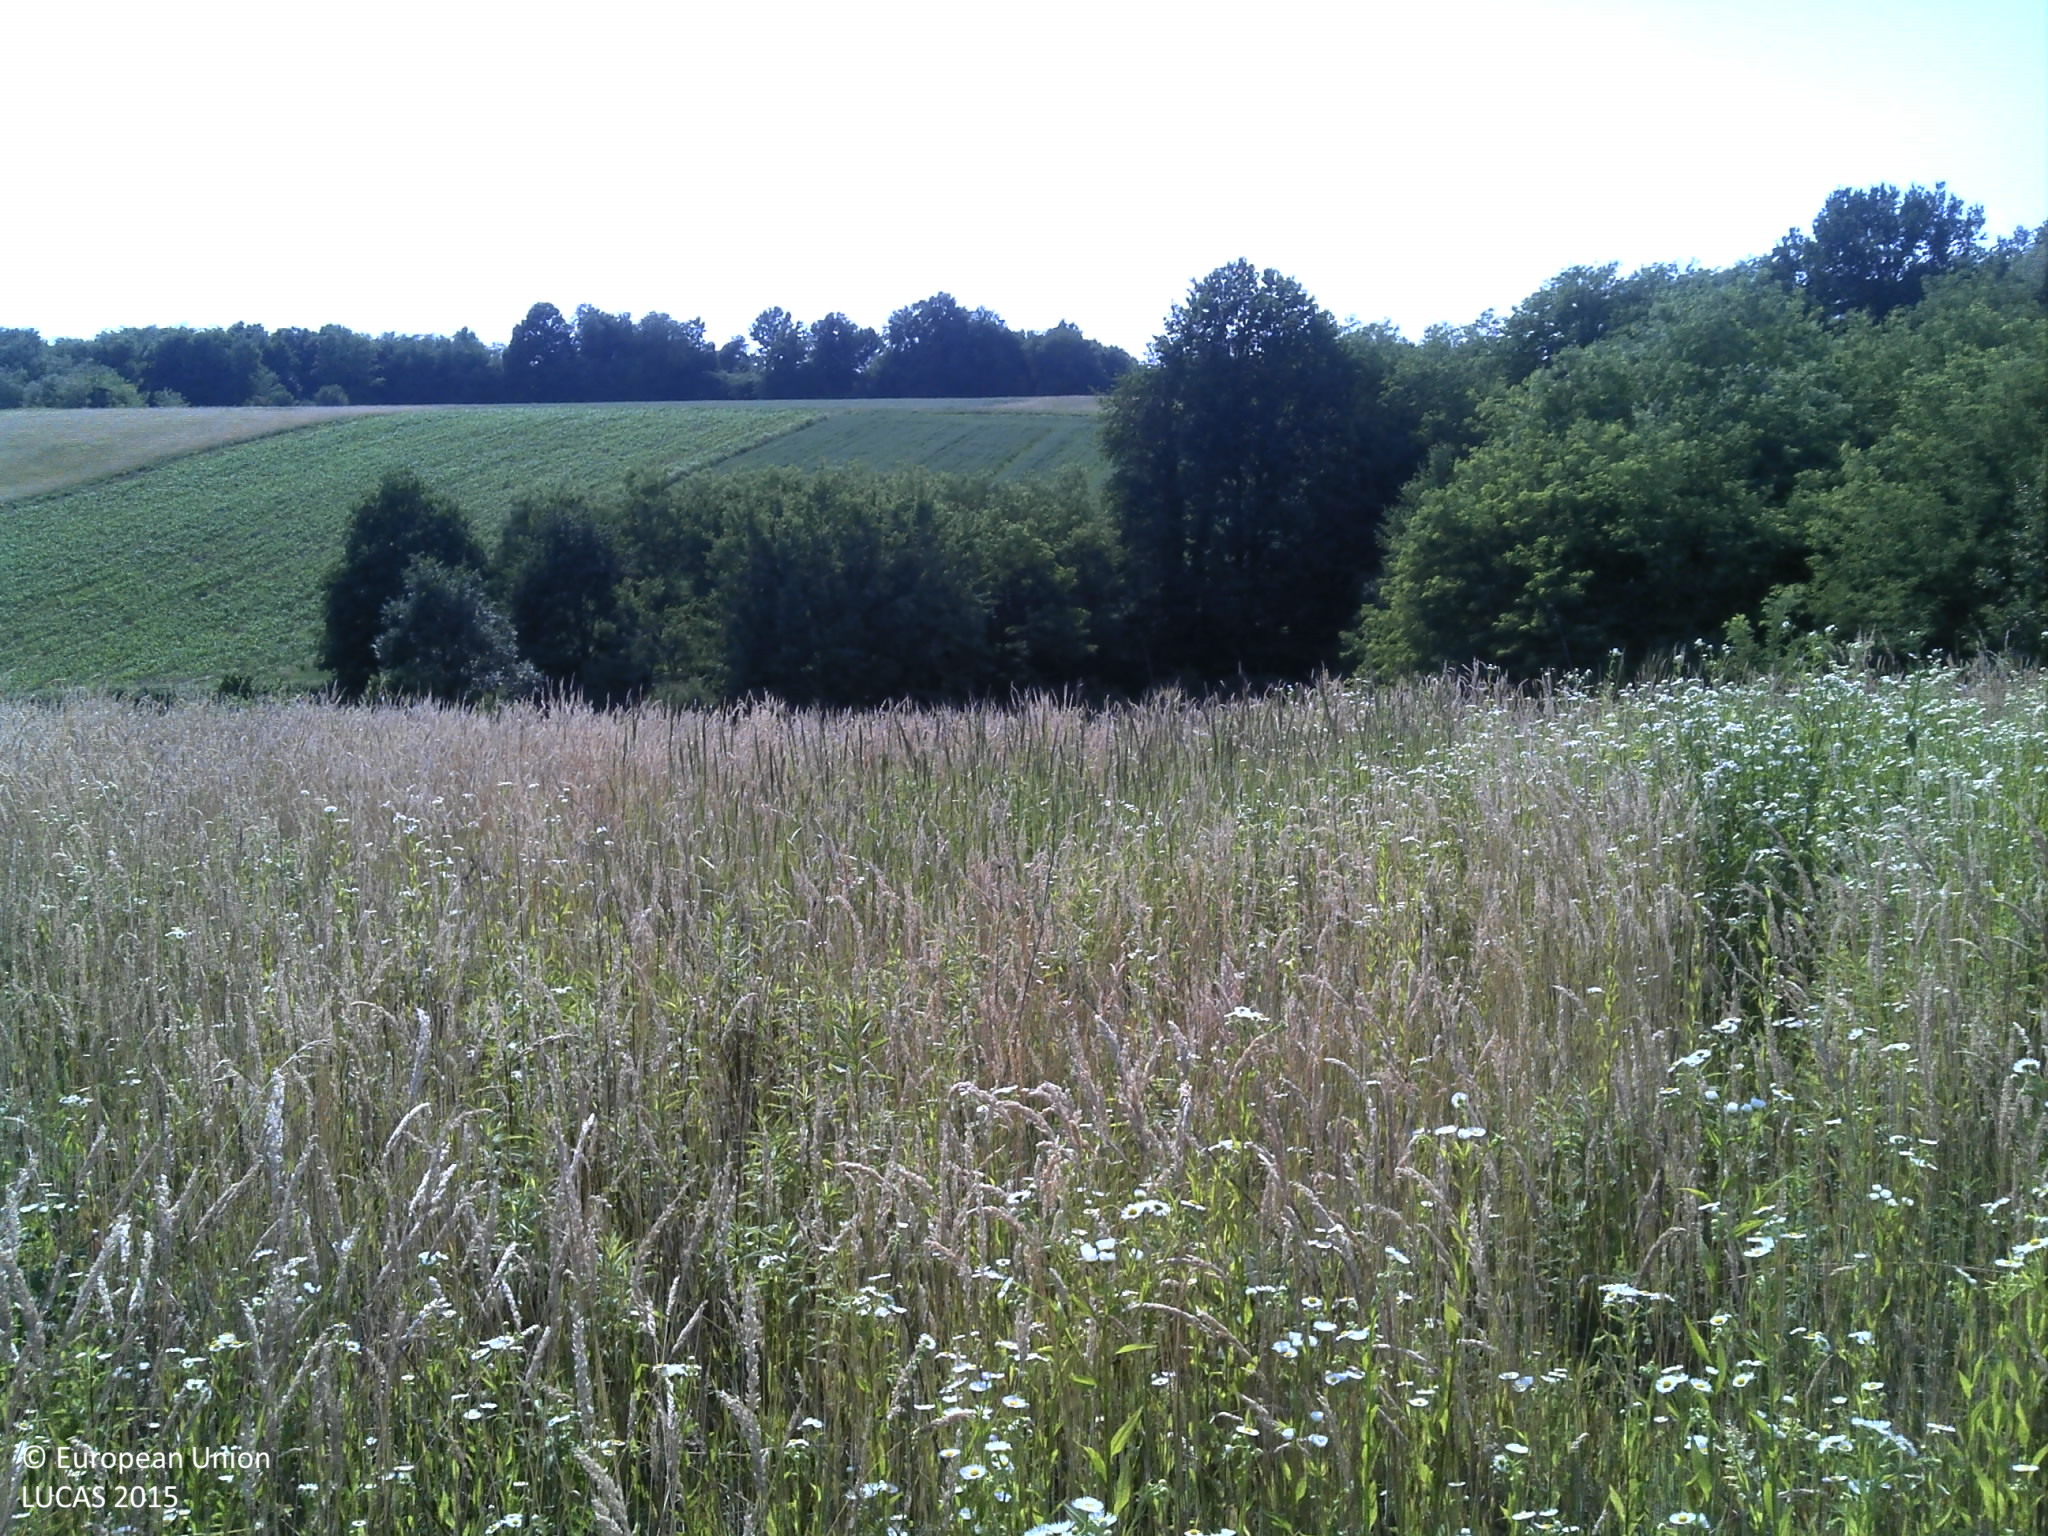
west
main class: Grassland
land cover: Spontaneously vegetated surfaces
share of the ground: > 75 %
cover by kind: herbaceous plants 100 %
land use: Semi-natural and natural areas not in use
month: June
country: HR
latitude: 45.4609
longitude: 17.1490
